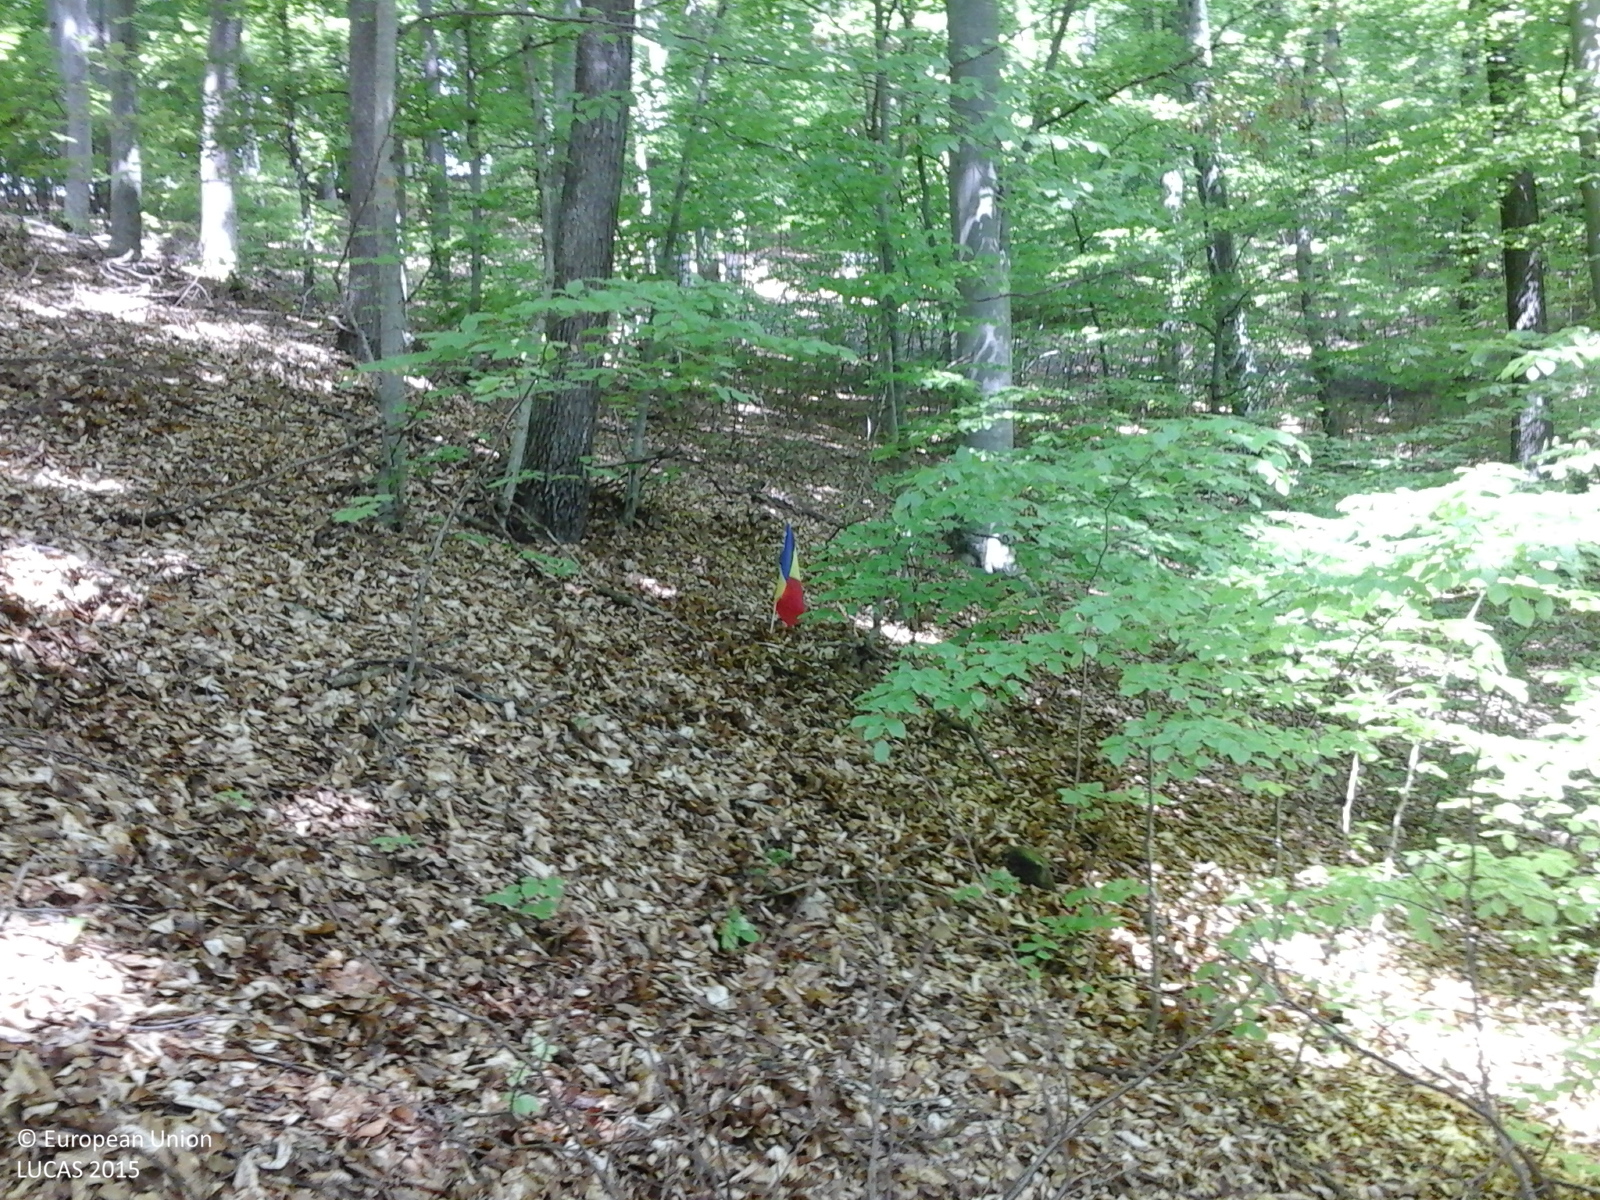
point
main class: Woodland
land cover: Broadleaved woodland
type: beech forest
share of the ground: > 75 %
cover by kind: broadleaved forest trees 100 %
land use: Forestry
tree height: > 5 m
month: May
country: RO
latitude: 45.8563
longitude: 25.7317
